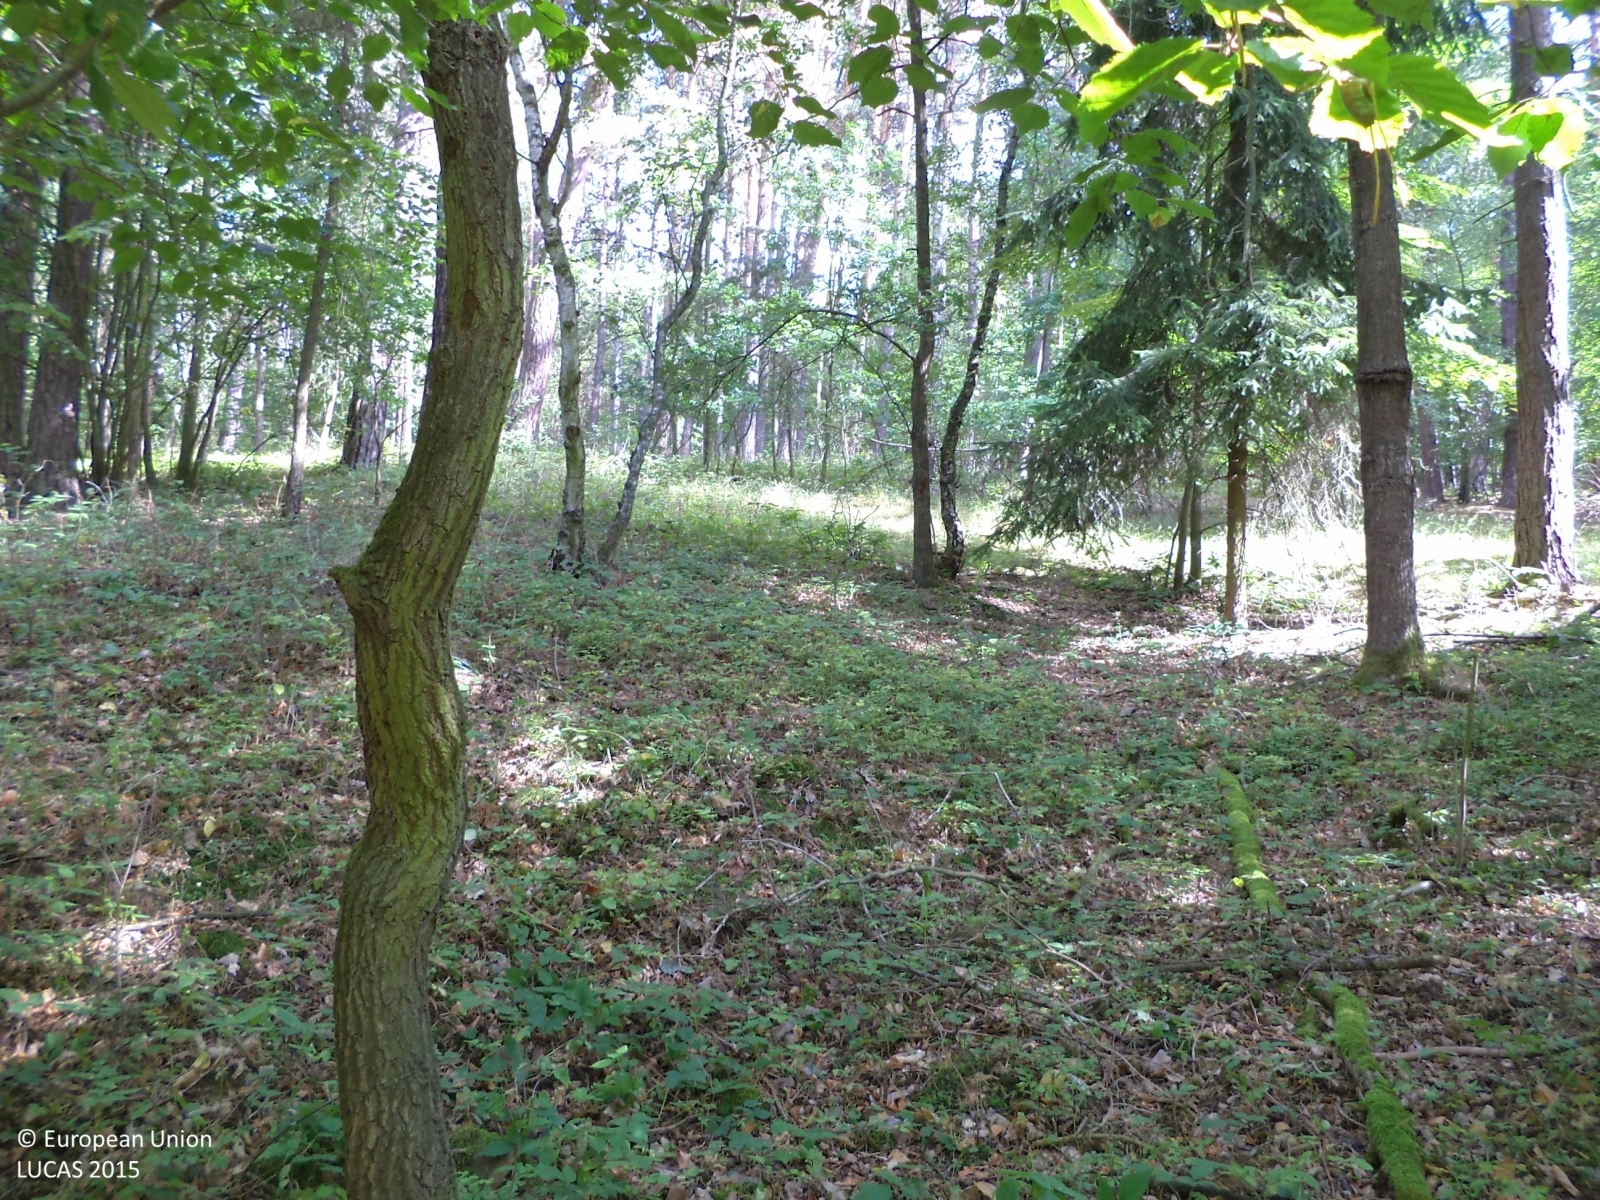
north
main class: Woodland
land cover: Pine dominated mixed woodland
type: hemiboreal forest and nemoral coniferous forest and mixed broadleaved-coniferous forest
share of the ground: > 75 %
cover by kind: coniferous forest trees 60 %, broadleaved forest trees 40 %
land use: Forestry
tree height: > 5 m
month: July
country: CZ
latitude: 49.7180
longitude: 14.4815
